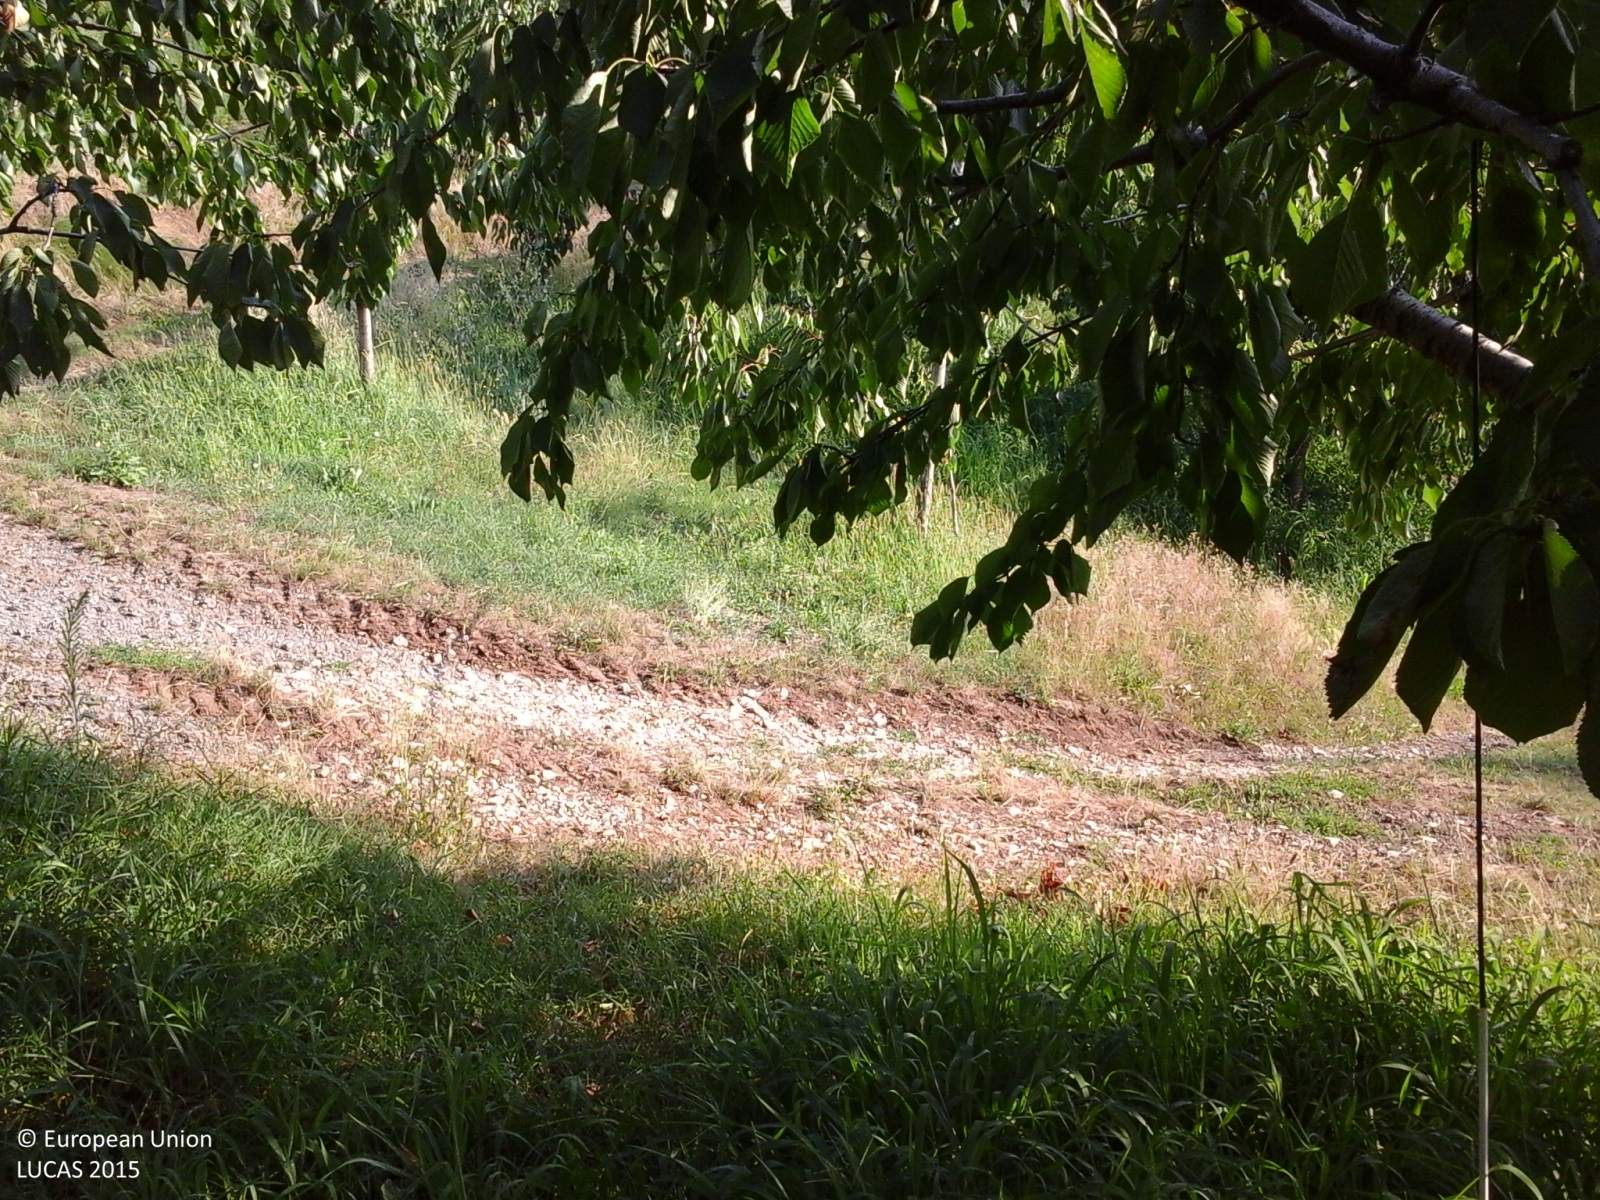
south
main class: Cropland
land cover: Cherry fruit
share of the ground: > 75 %
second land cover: Grassland without tree/shrub cover
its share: > 75 %
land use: Agriculture (excluding fallow land and kitchen gardens)
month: July
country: IT
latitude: 45.5512
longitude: 11.2404
